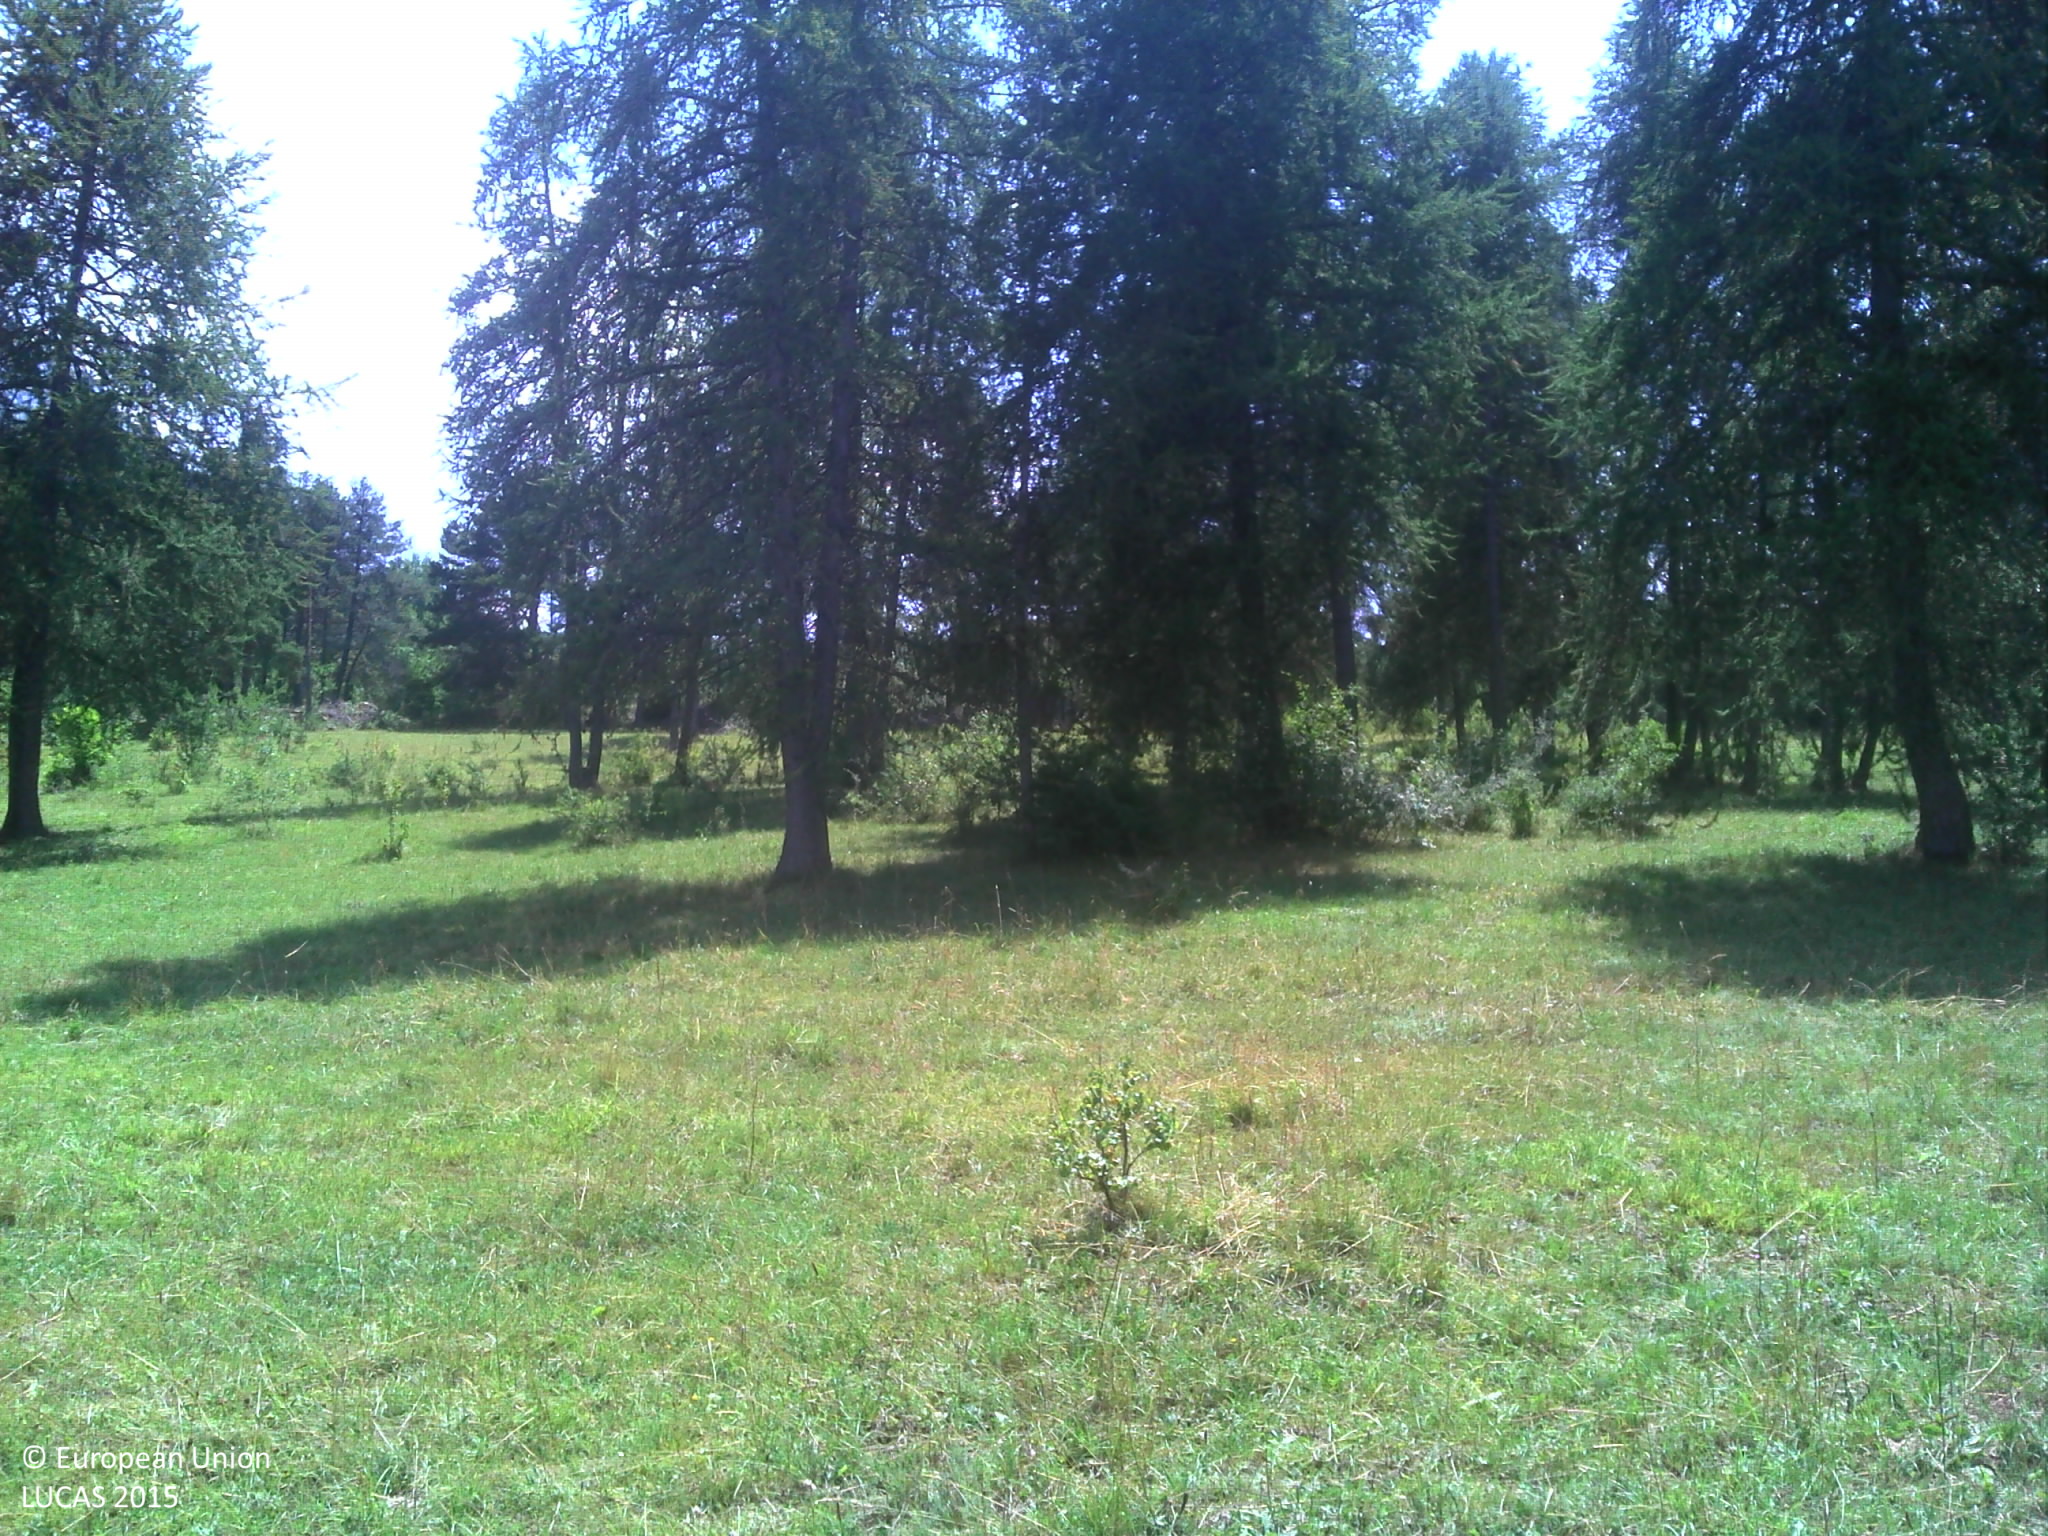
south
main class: Grassland
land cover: Grassland without tree/shrub cover
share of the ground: > 75 %
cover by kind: herbaceous plants 90 %, consolidated bare surface 10 %
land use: Agriculture (excluding fallow land and kitchen gardens)
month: July
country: FR
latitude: 44.4308
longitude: 6.3511
